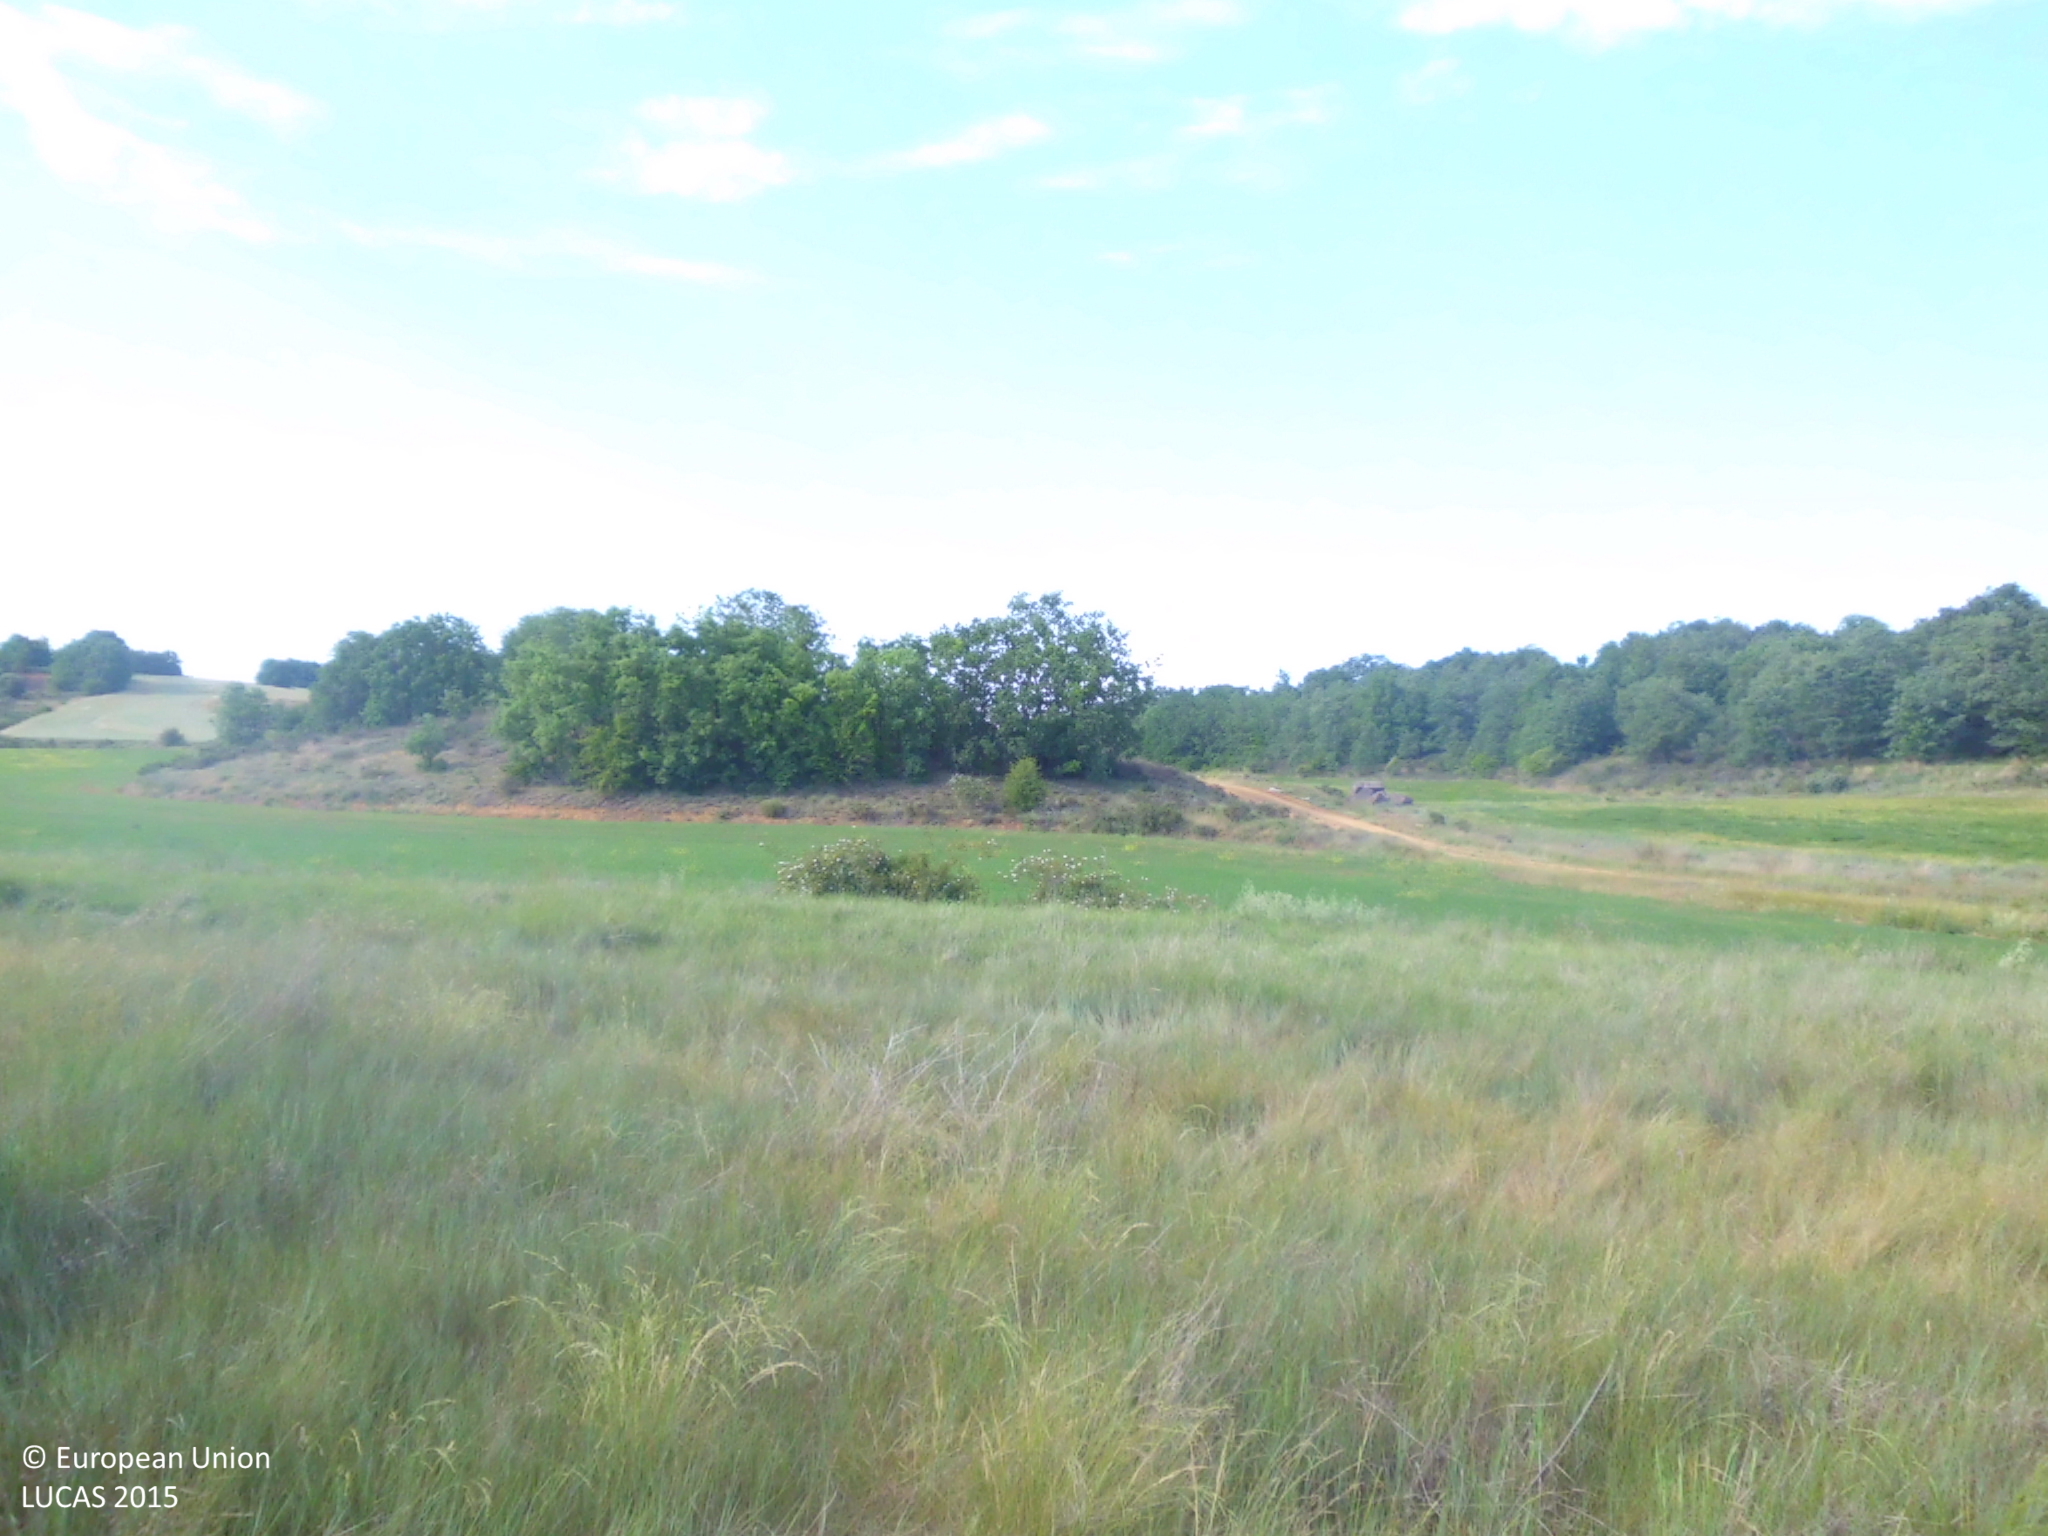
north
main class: Grassland
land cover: Grassland without tree/shrub cover
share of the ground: > 75 %
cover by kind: herbaceous plants 100 %
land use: Agriculture (excluding fallow land and kitchen gardens)
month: June
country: ES
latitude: 42.4952
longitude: -4.4195
